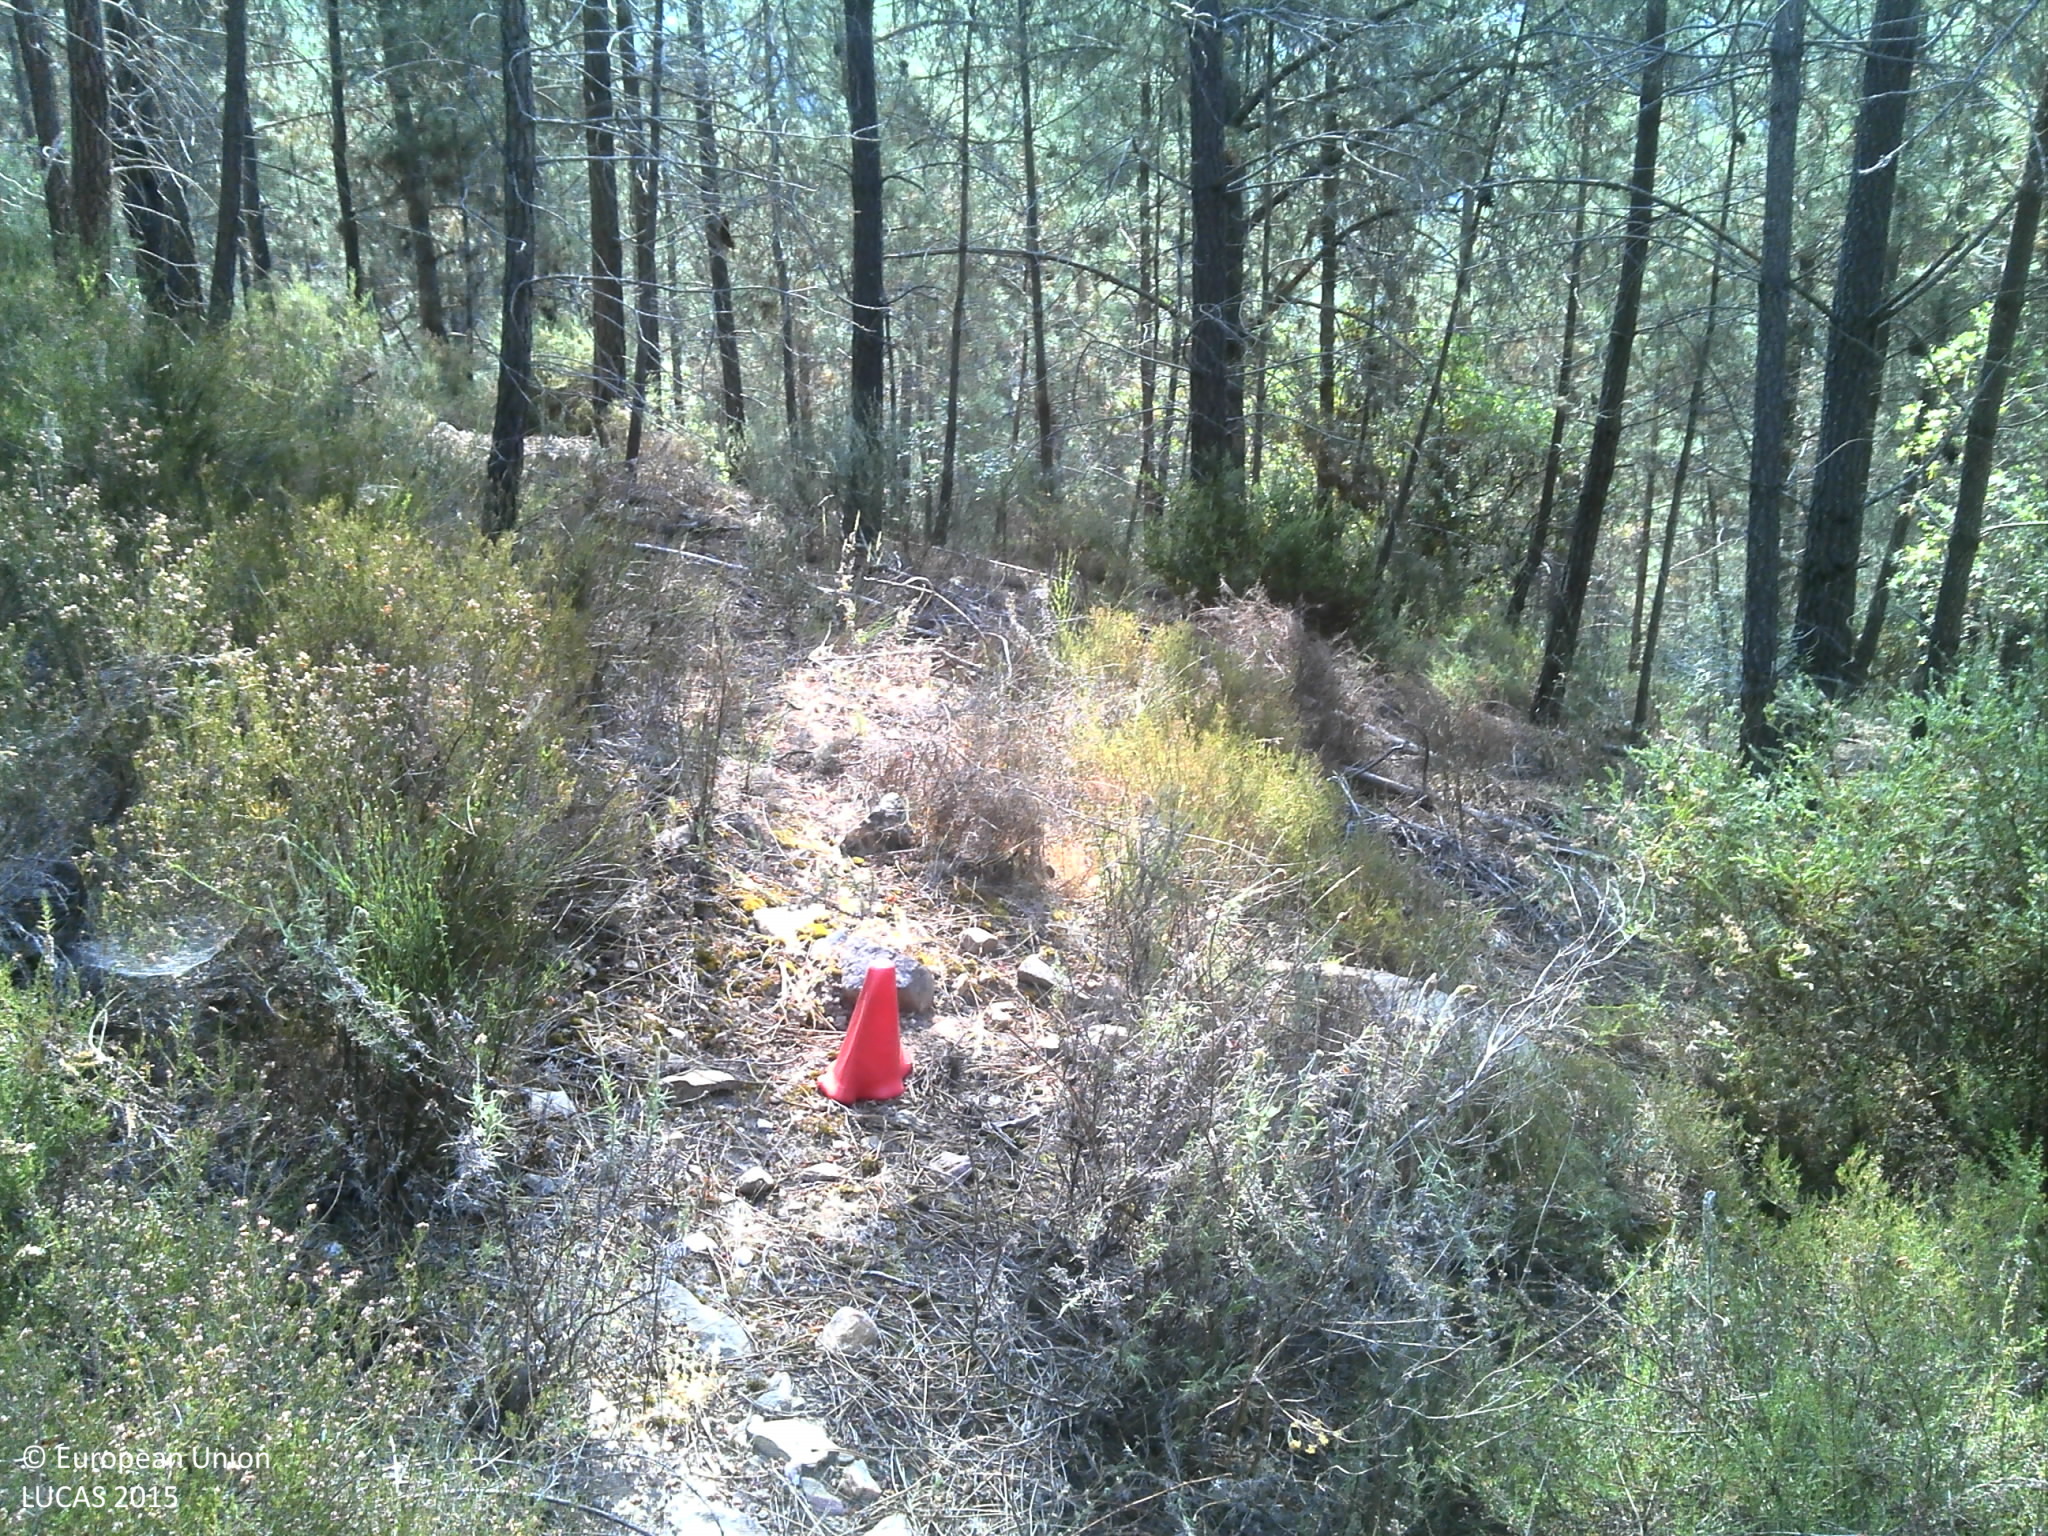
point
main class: Woodland
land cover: Pine dominated coniferous woodland
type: coniferous forest of the mediterranean region
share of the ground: 50 - 75 %
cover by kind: coniferous forest trees 60 %, unconsolidated bare surface 25 %, shrubs 15 %
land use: Forestry
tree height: > 5 m
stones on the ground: 10 - 25 %
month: June
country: PT
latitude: 41.2614
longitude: -7.5143
